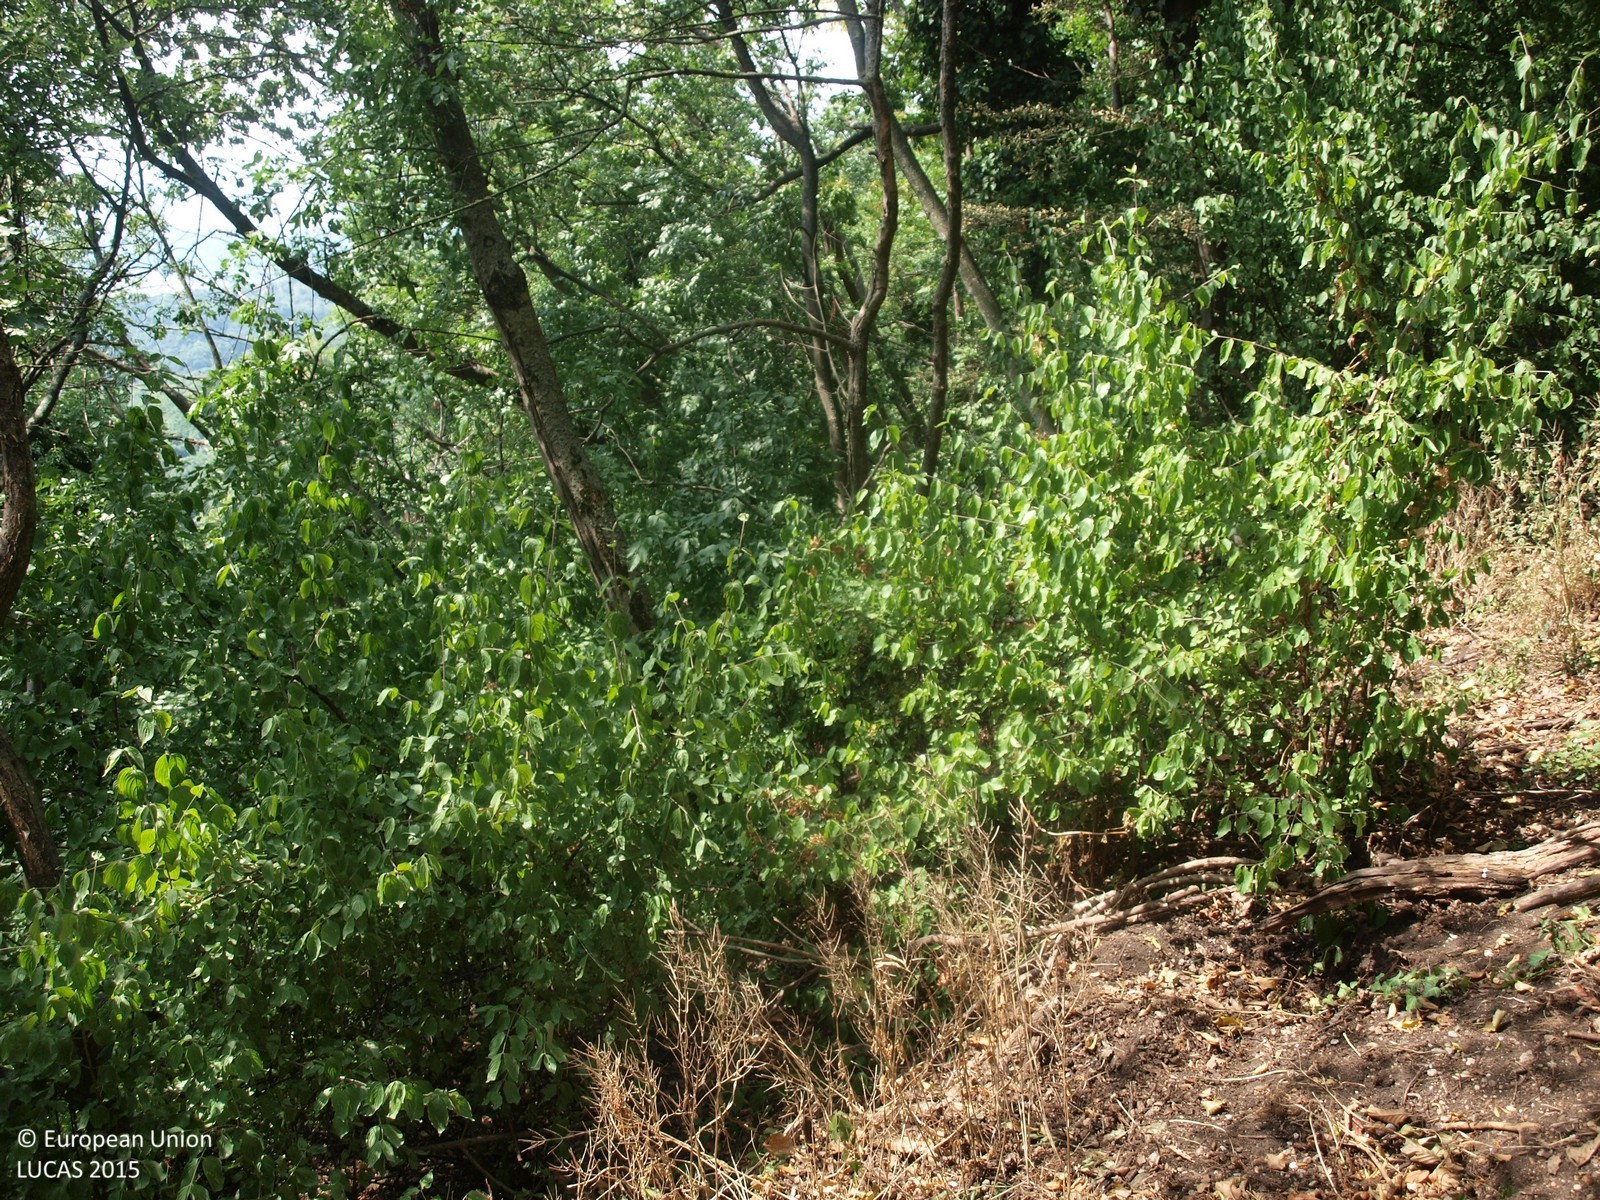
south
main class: Woodland
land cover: Broadleaved woodland
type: mesophytic deciduous forest
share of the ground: > 75 %
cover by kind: broadleaved forest trees 100 %
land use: Forestry
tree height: > 5 m
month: August
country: HR
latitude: 46.1246
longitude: 16.3799
